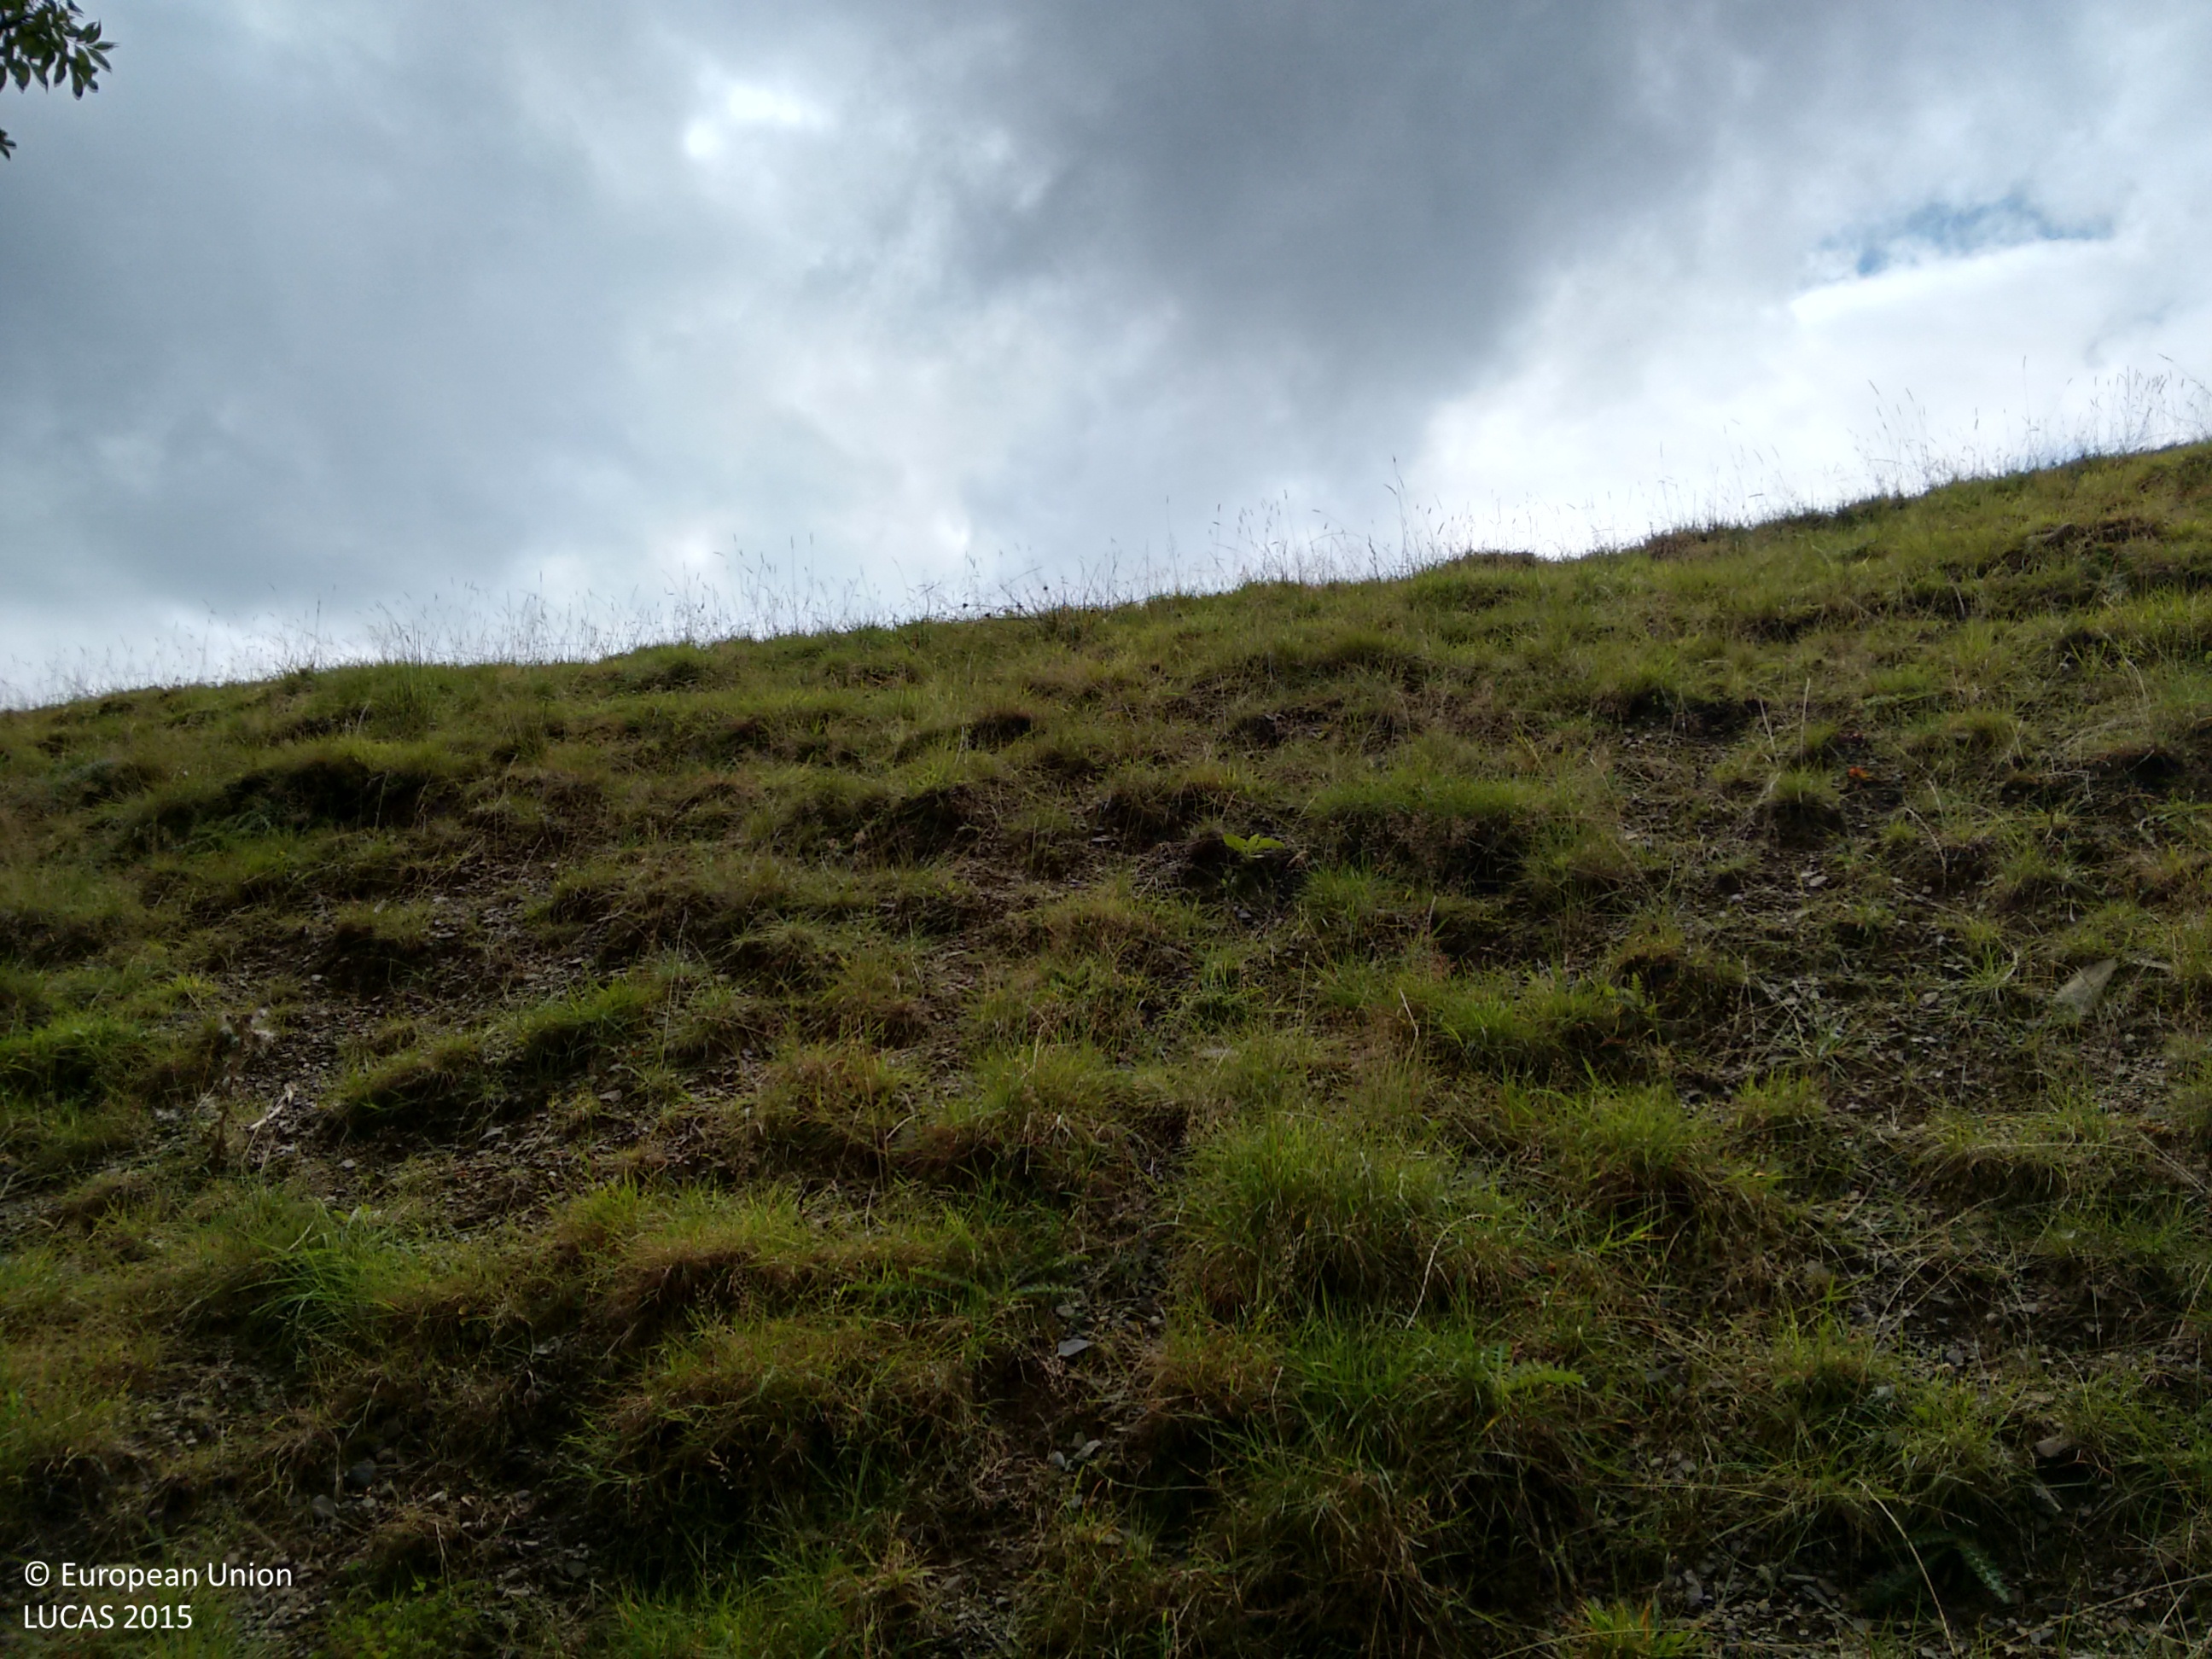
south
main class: Woodland
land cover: Broadleaved woodland
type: mesophytic deciduous forest
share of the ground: > 75 %
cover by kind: broadleaved forest trees 80 %, herbaceous plants 20 %
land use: Agriculture (excluding fallow land and kitchen gardens)
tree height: > 5 m
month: September
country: GB
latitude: 52.1823
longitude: -3.5257
